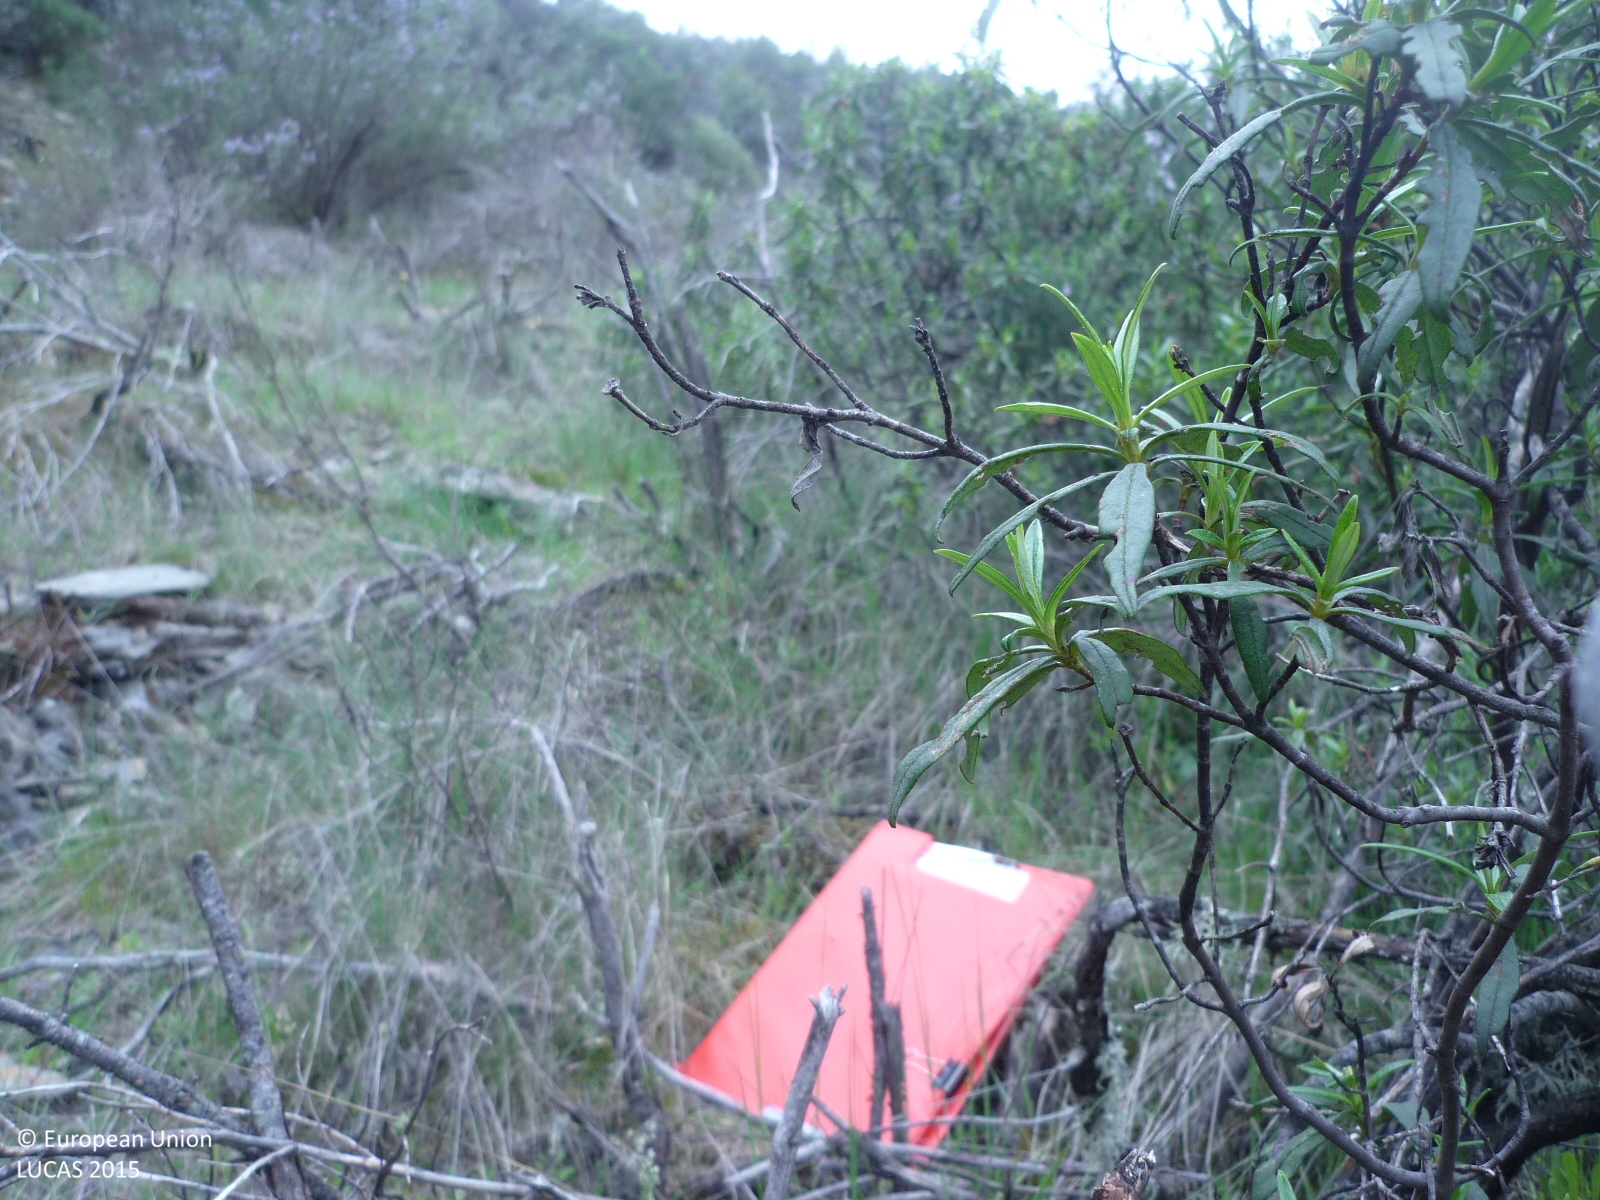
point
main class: Shrubland
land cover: Shrubland with sparse tree cover
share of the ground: > 75 %
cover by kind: shrubs 85 %, herbaceous plants 10 %, coniferous forest trees 5 %
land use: Semi-natural and natural areas not in use
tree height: > 5 m
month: April
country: ES
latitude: 40.9408
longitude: -3.4990
